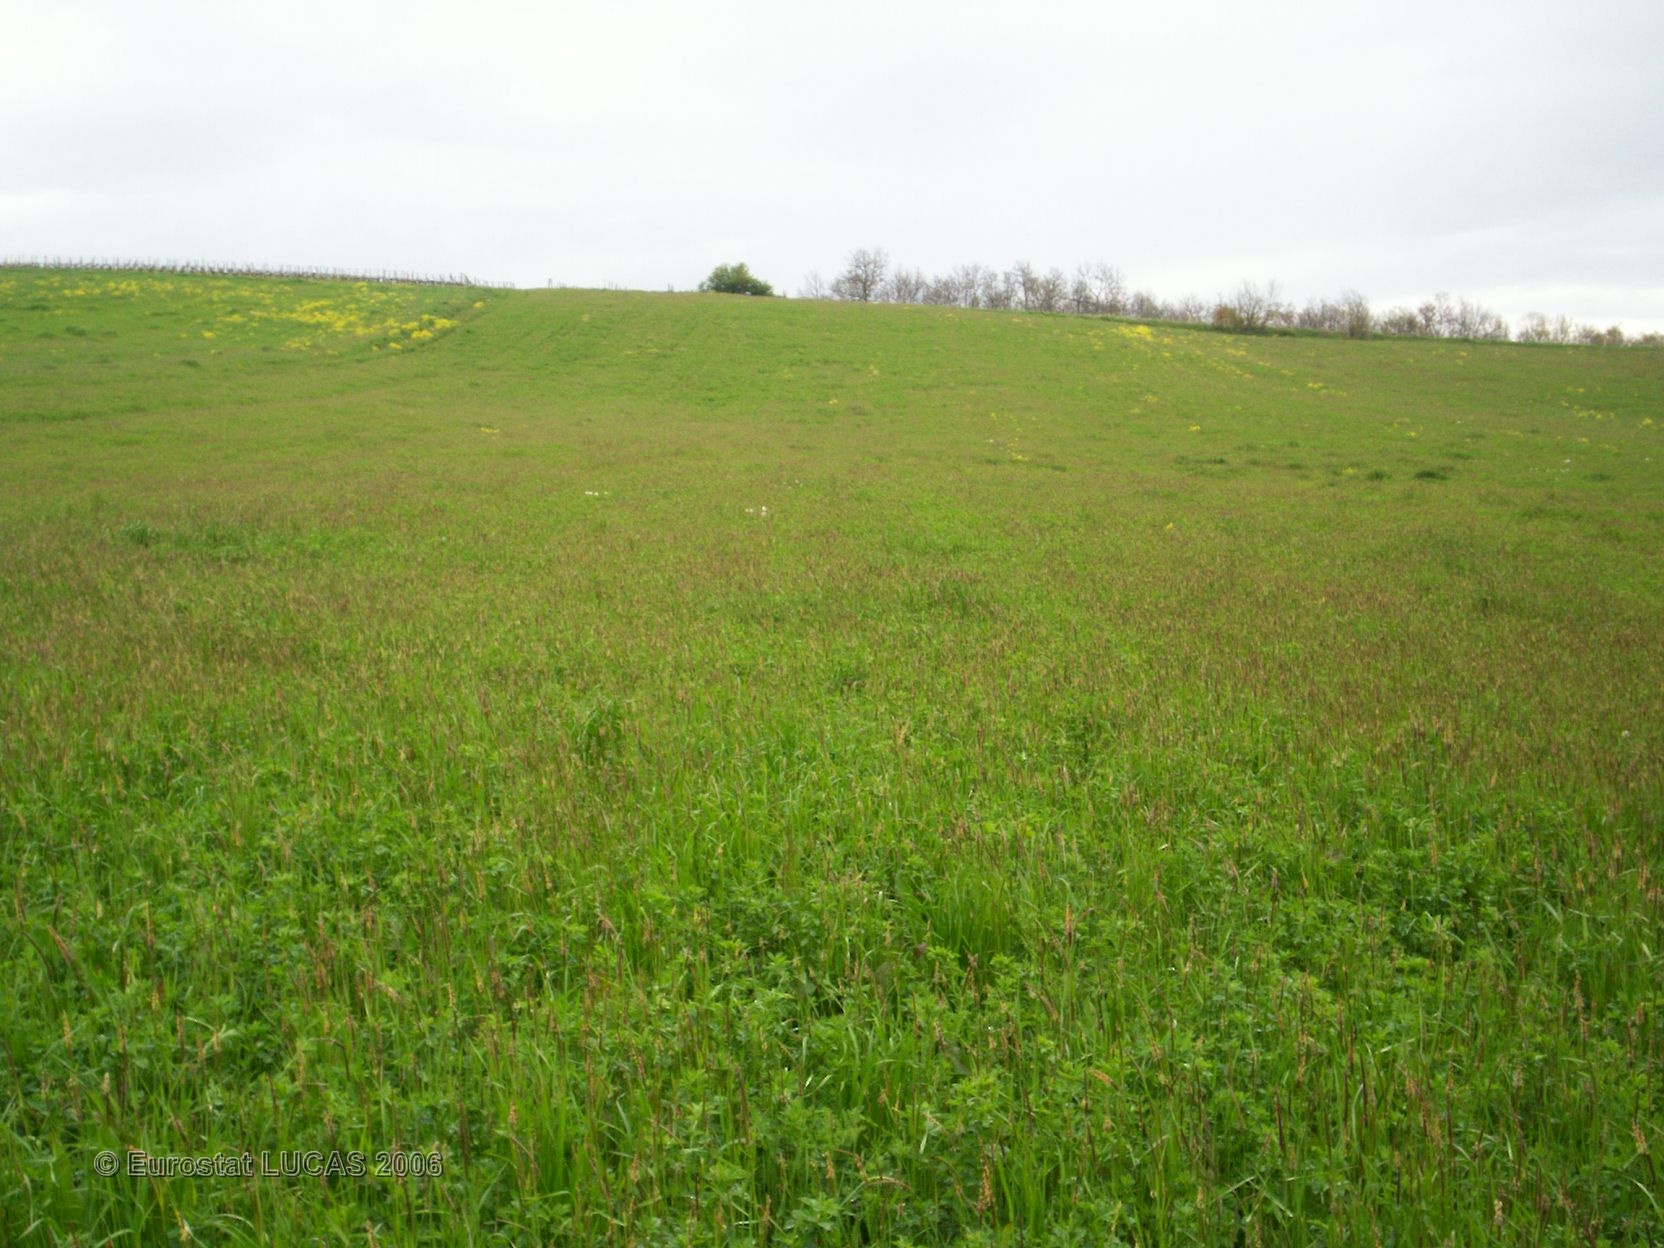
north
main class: Cropland
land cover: Other leguminous and mixtures for fodder
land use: Agriculture (excluding fallow land and kitchen gardens)
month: April
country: FR
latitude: 43.7114
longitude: 0.2776
